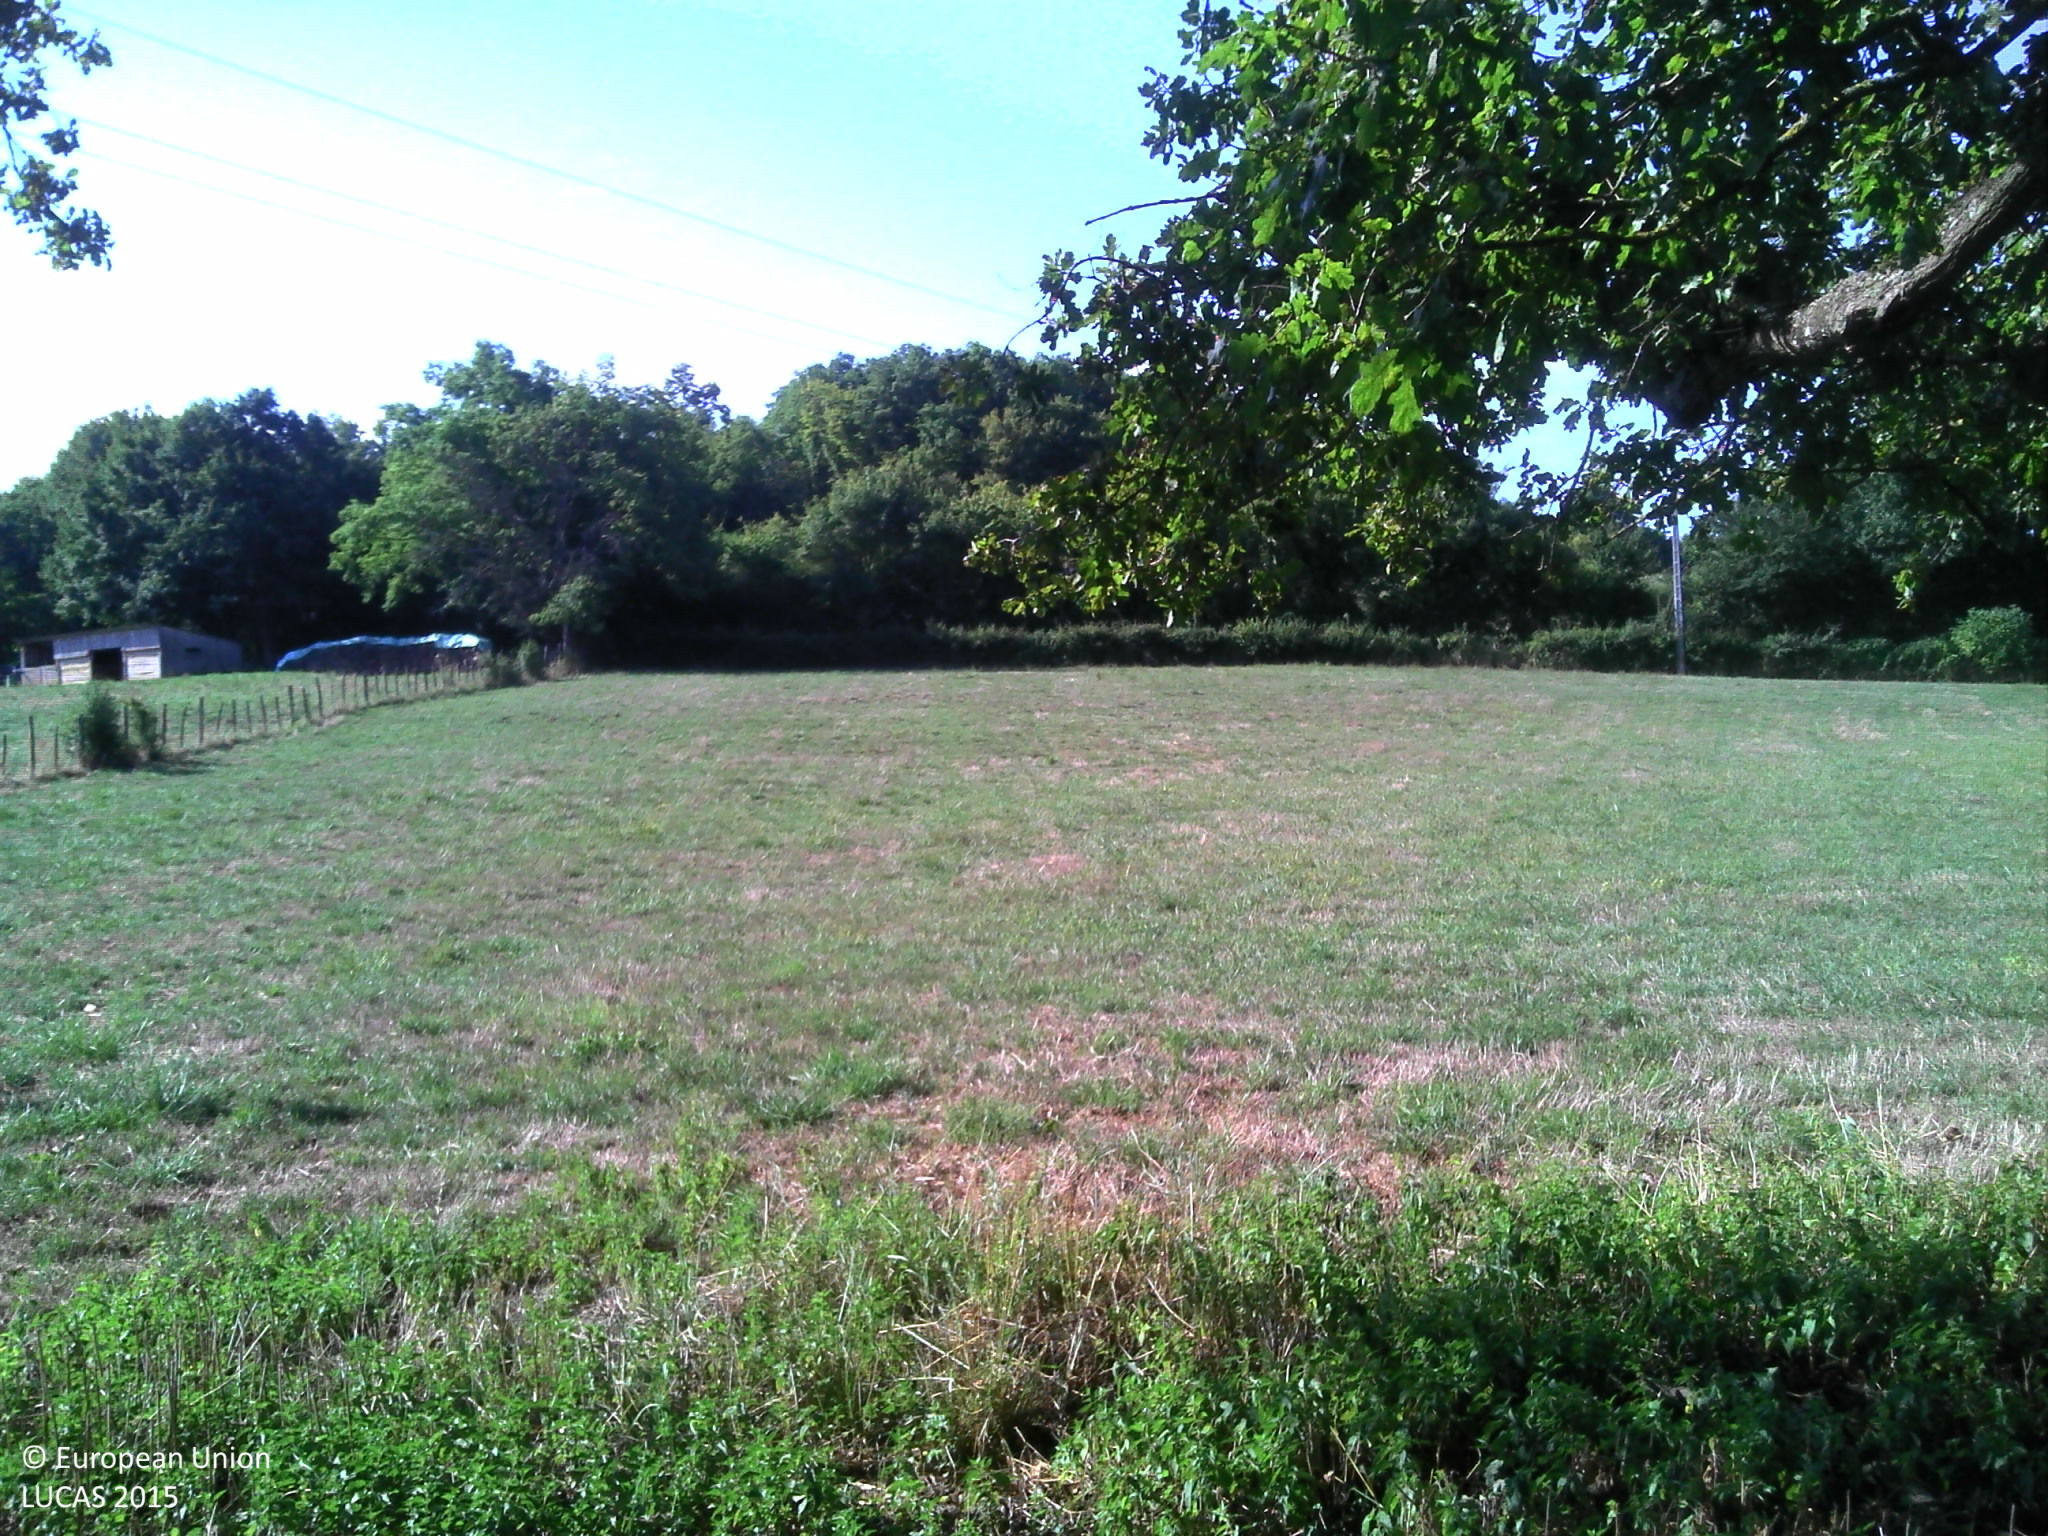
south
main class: Grassland
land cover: Grassland with sparse tree/shrub cover
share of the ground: > 75 %
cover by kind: herbaceous plants 95 %, broadleaved forest trees 5 %
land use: Agriculture (excluding fallow land and kitchen gardens)
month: August
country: FR
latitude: 46.3686
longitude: 4.7895
